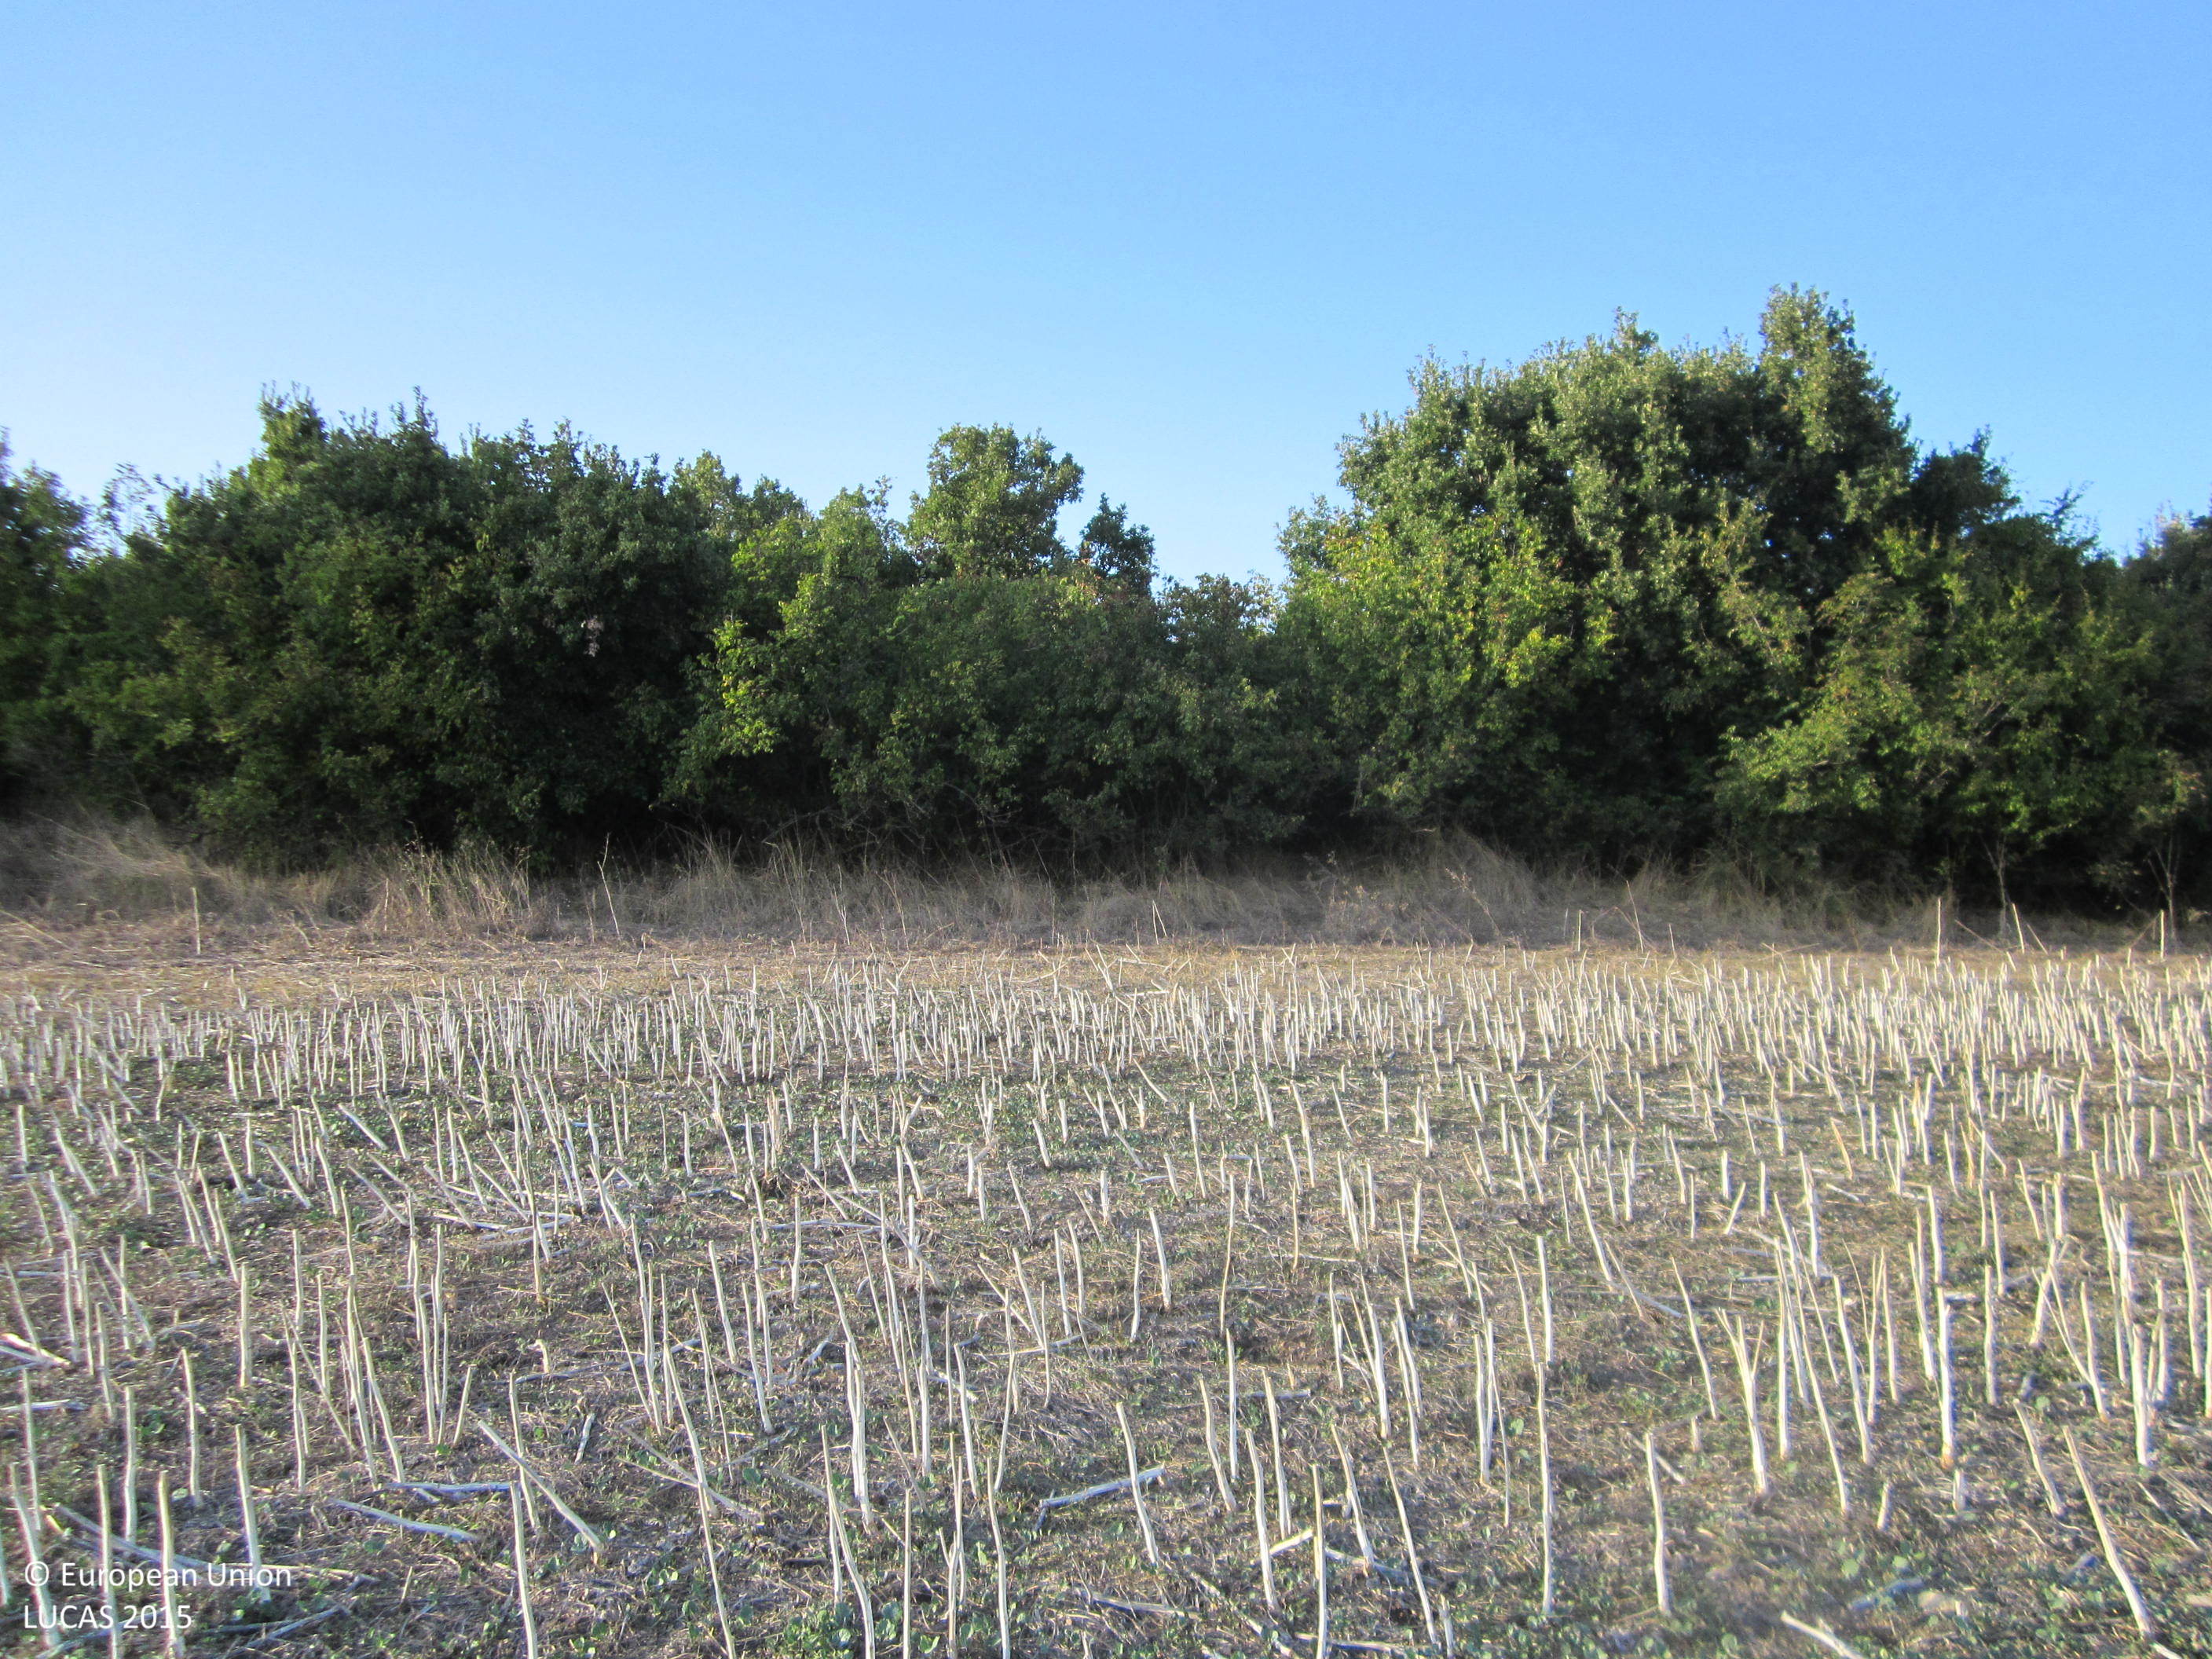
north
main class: Cropland
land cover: Rape and turnip rape
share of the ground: 10 - 25 %
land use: Agriculture (excluding fallow land and kitchen gardens)
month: September
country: BG
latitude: 42.6538
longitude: 27.3524
